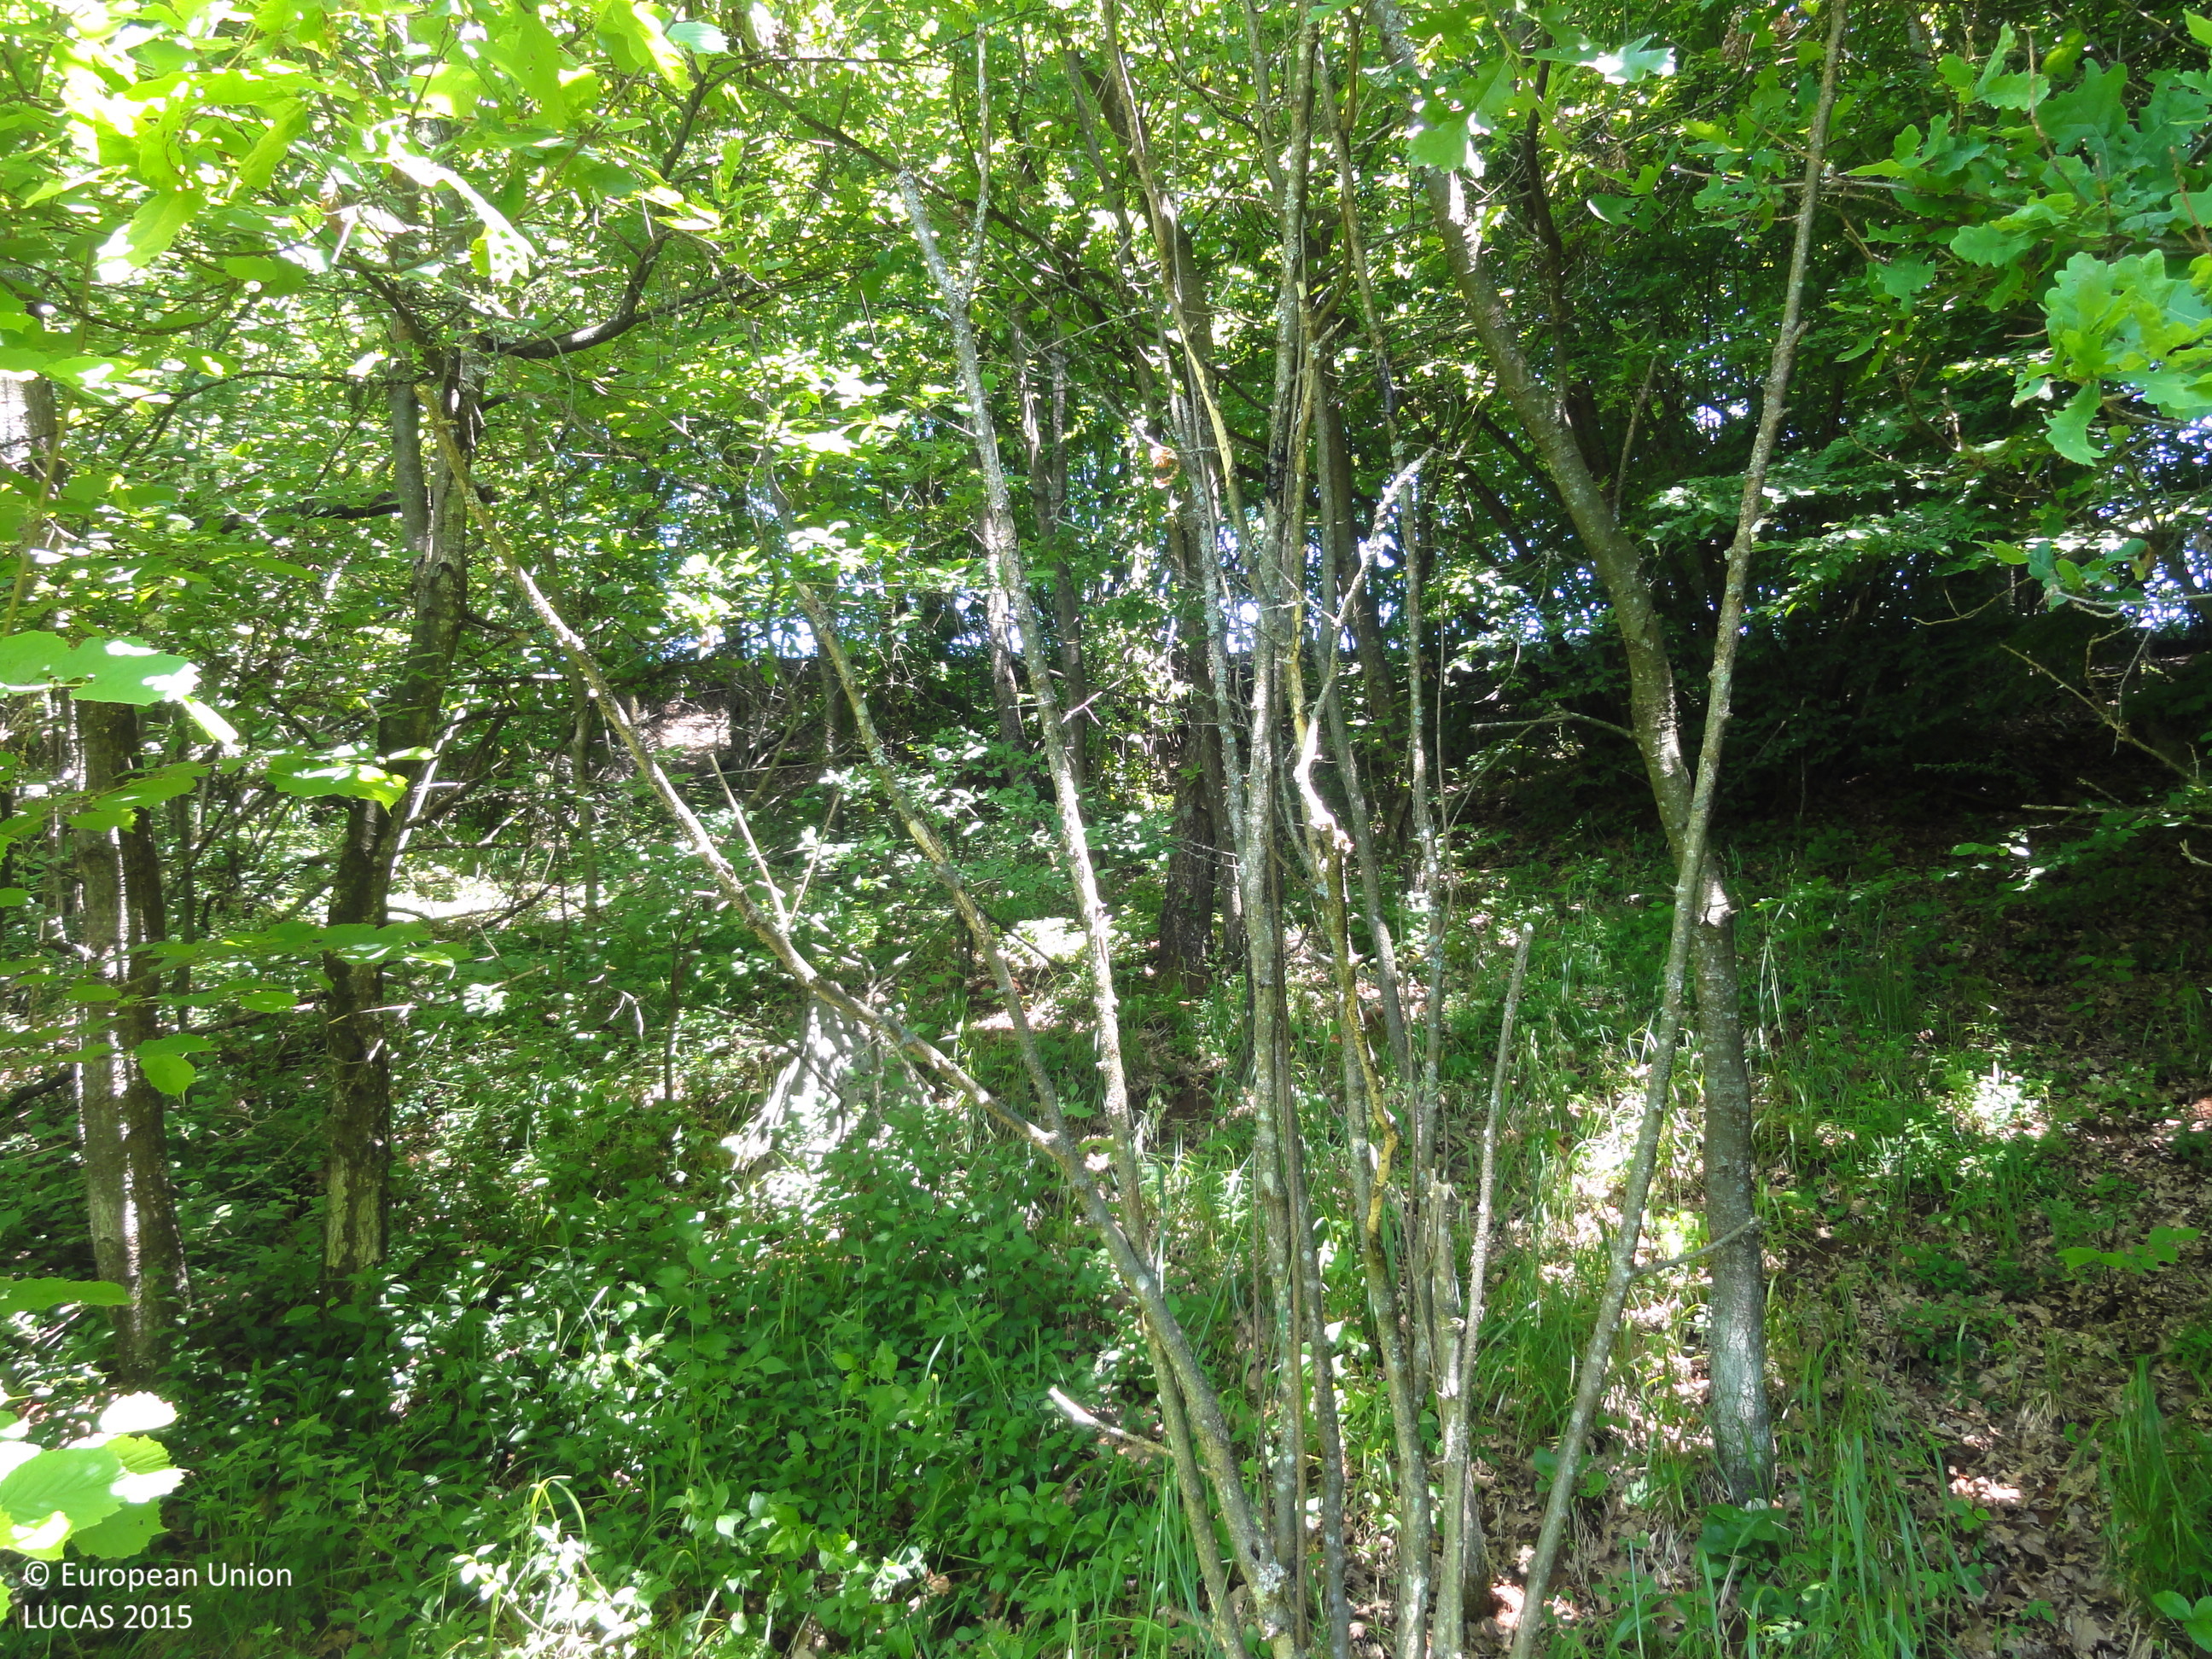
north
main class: Woodland
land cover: Broadleaved woodland
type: mesophytic deciduous forest
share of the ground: > 75 %
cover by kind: broadleaved forest trees 100 %
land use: Semi-natural and natural areas not in use
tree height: > 5 m
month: May
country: SI
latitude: 45.8730
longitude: 15.0080
